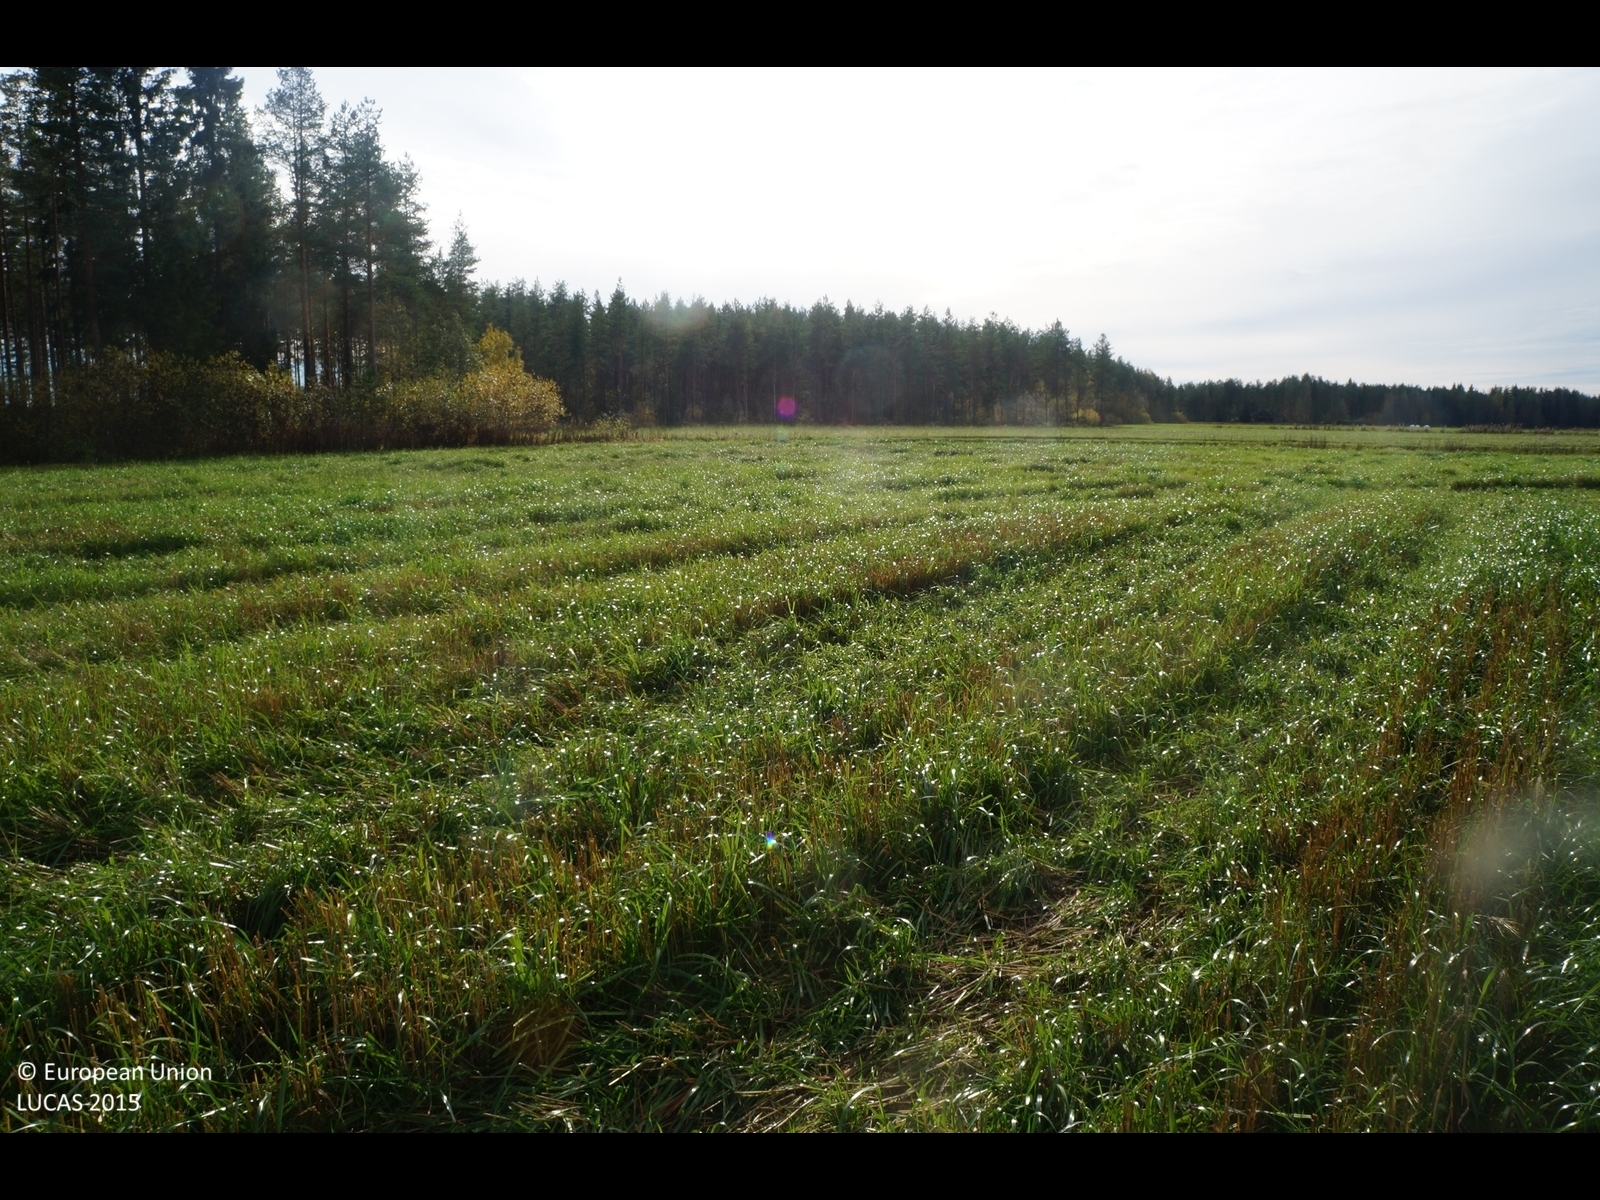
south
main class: Cropland
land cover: Temporary grasslands
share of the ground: > 75 %
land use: Agriculture (excluding fallow land and kitchen gardens)
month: September
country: FI
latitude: 63.8755
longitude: 24.0932
